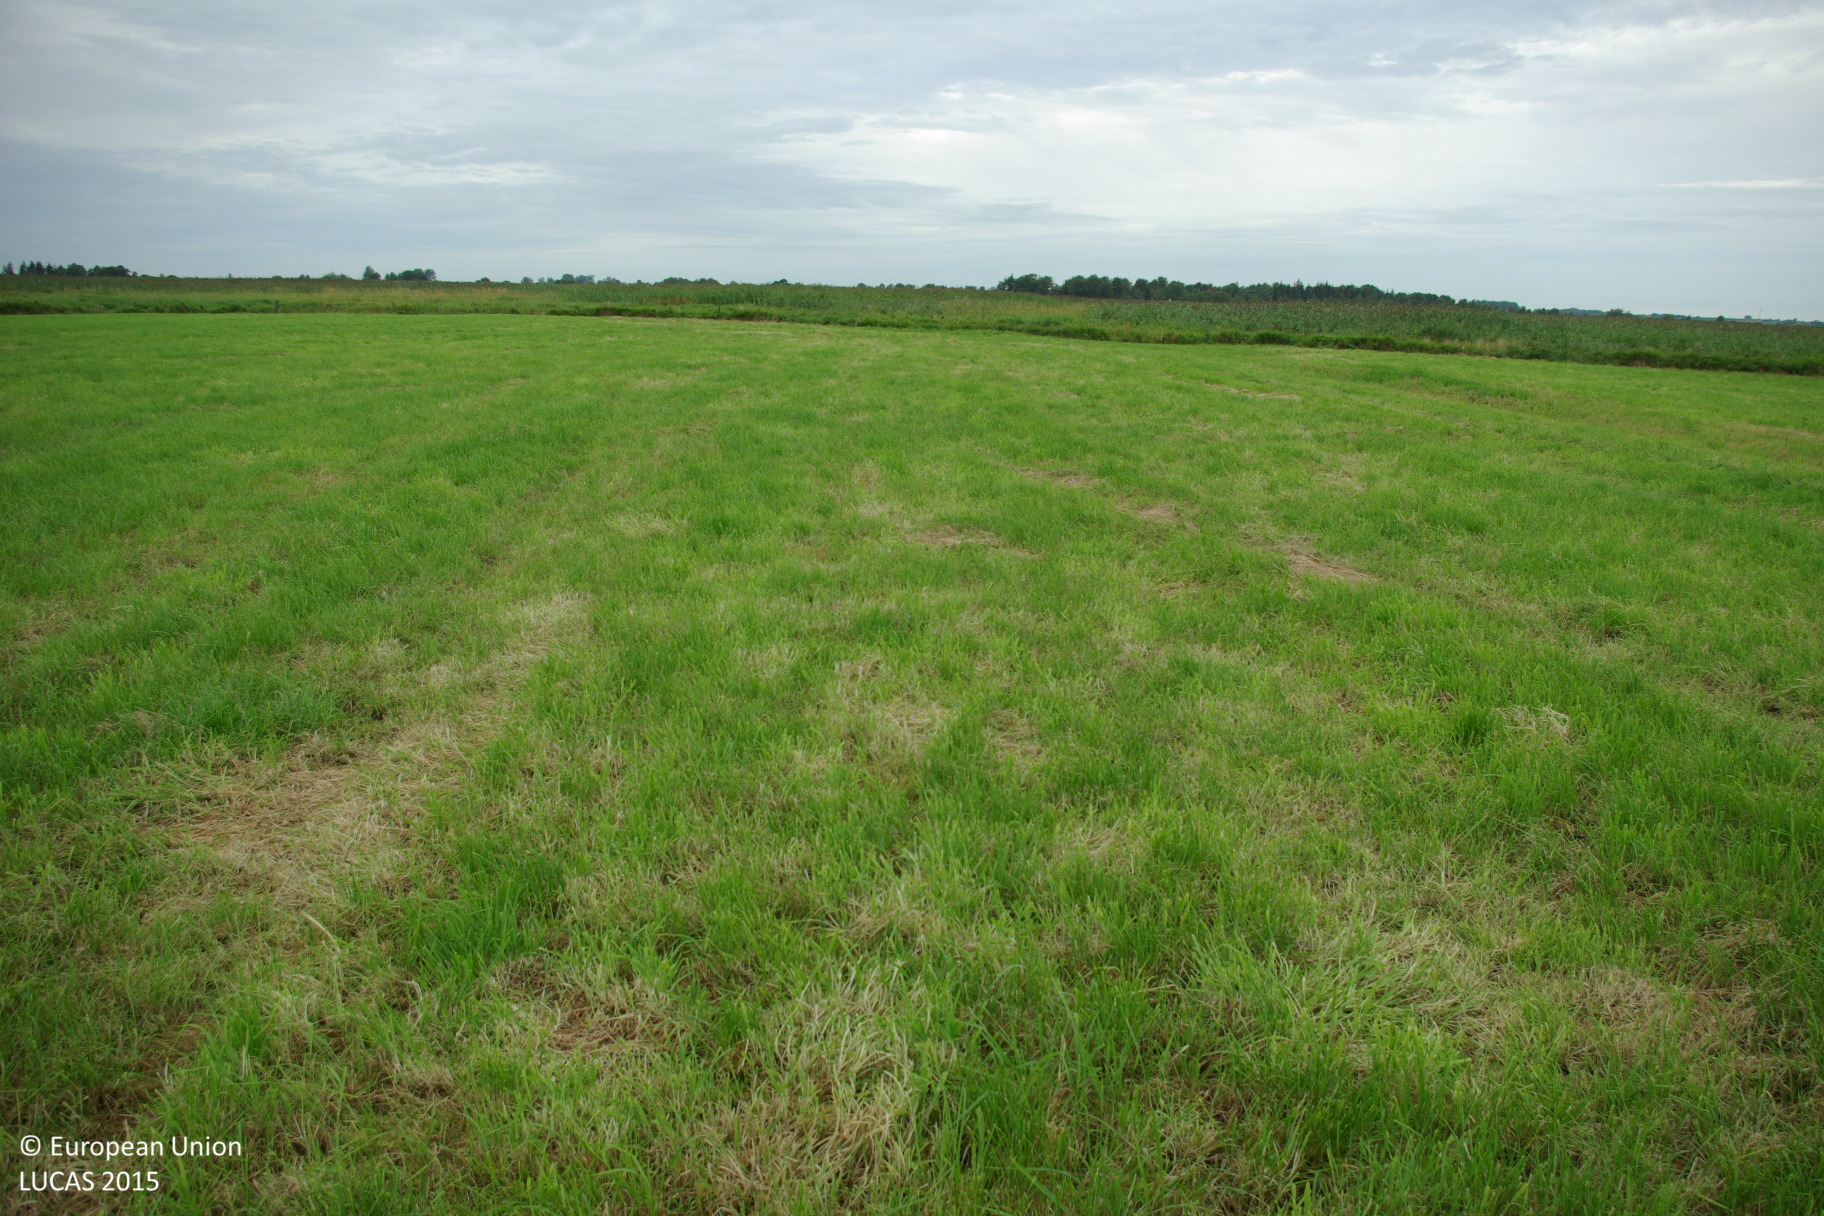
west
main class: Grassland
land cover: Grassland without tree/shrub cover
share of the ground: > 75 %
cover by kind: herbaceous plants 100 %
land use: Agriculture (excluding fallow land and kitchen gardens)
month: August
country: DE
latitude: 54.3345
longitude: 9.3084
